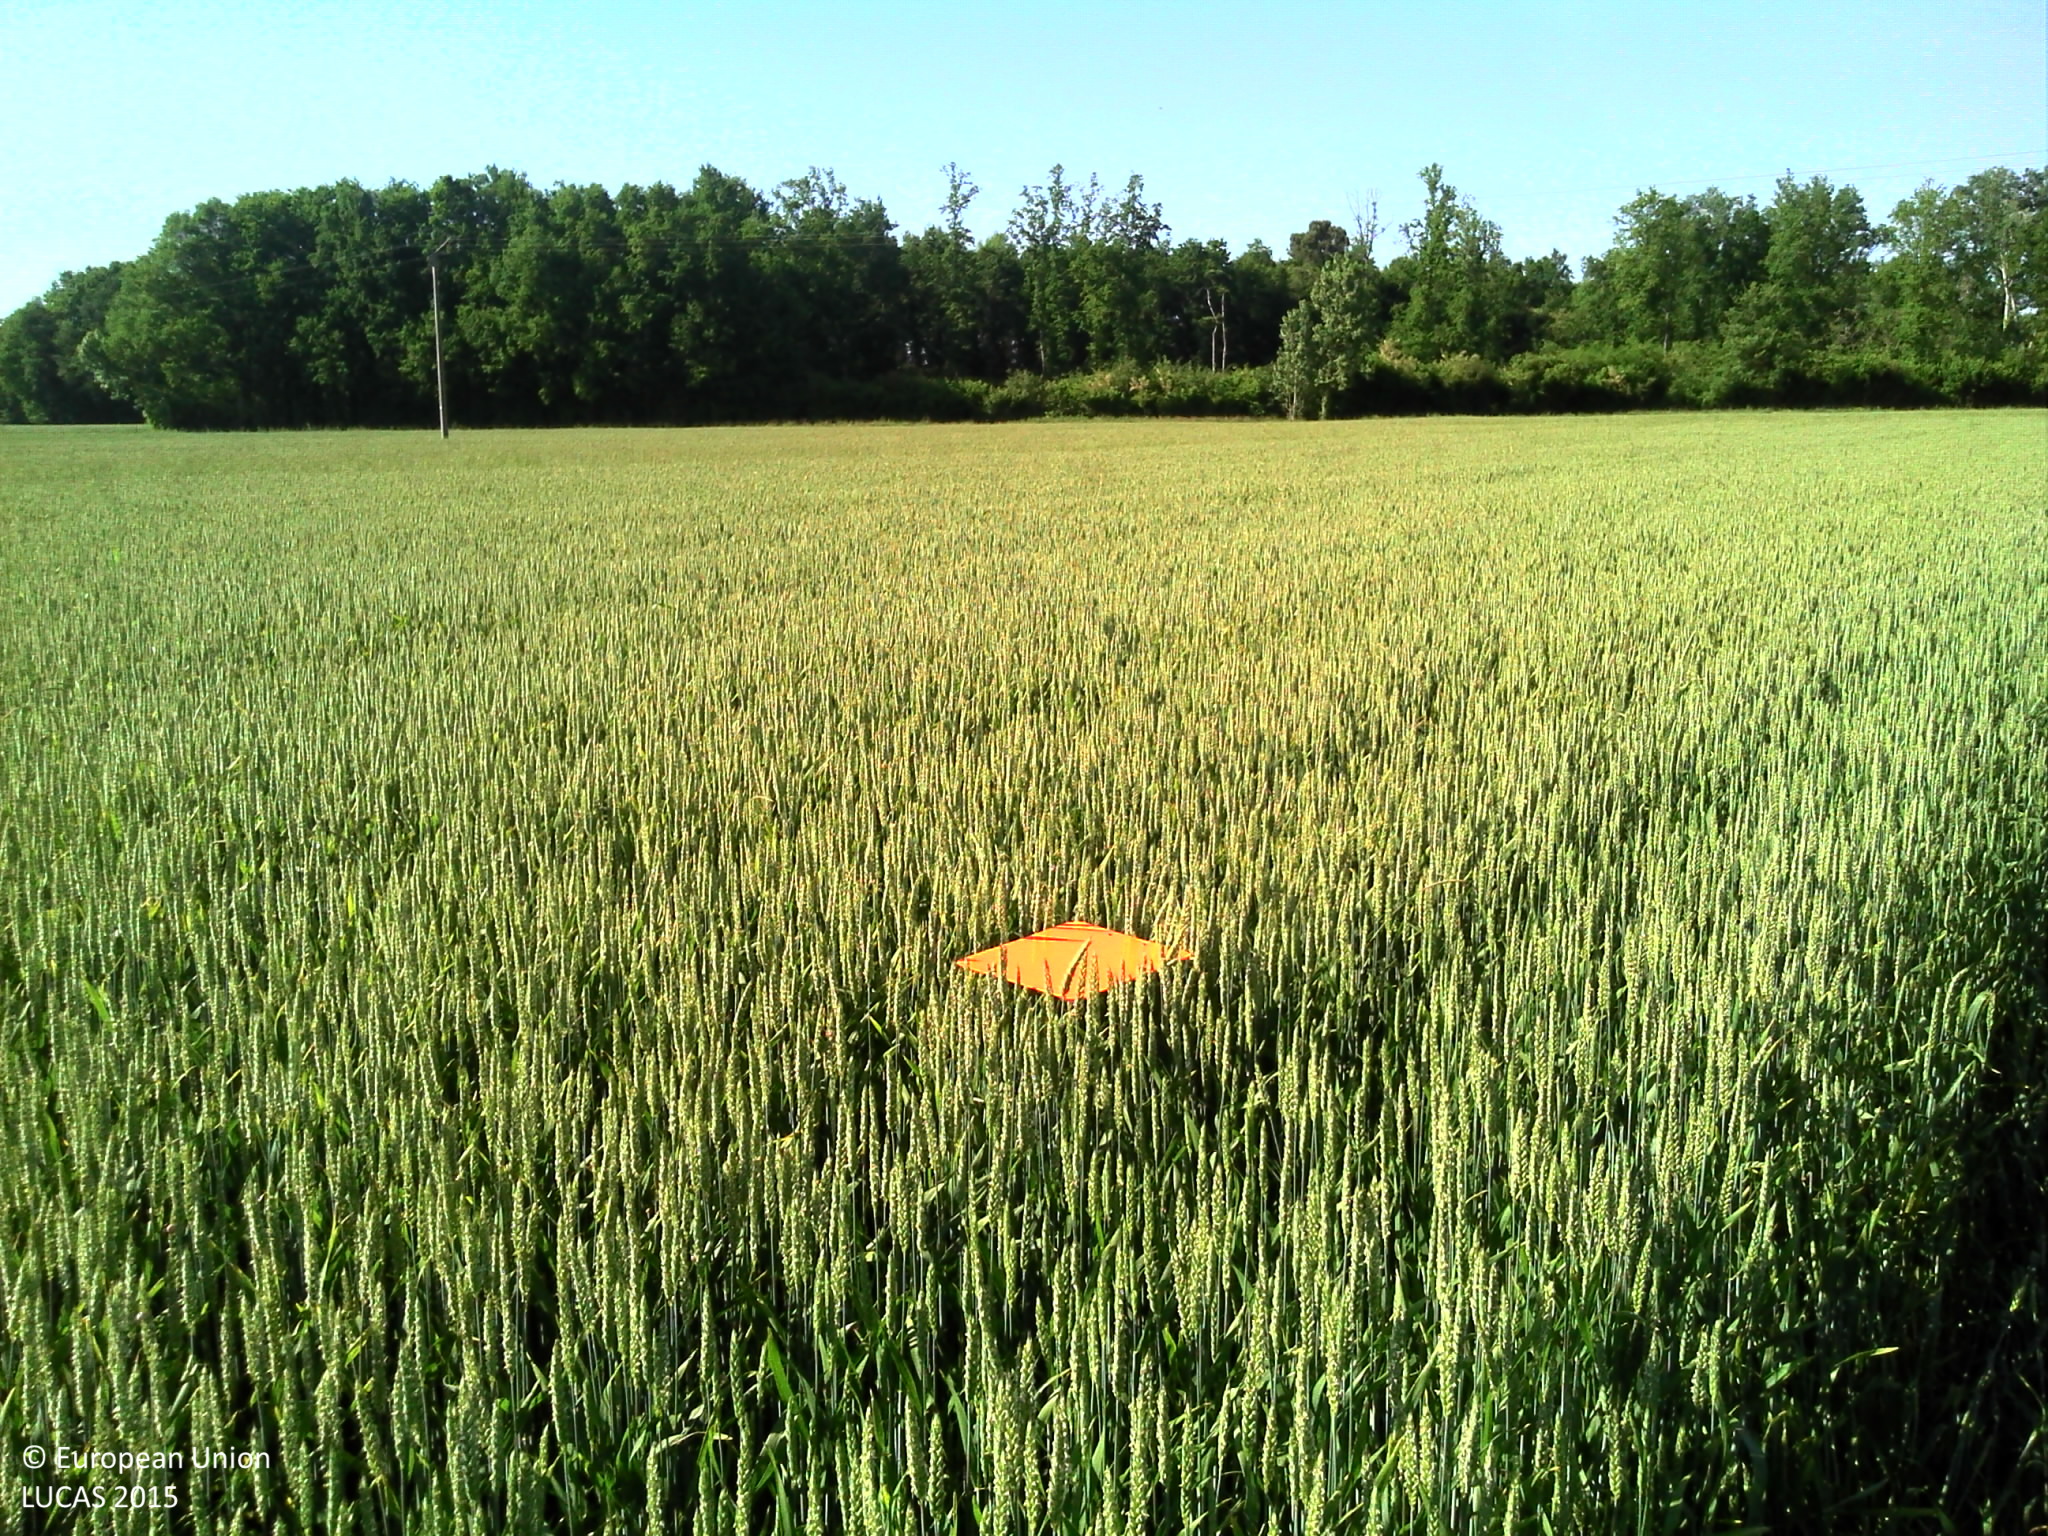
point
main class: Cropland
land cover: Common wheat
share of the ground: > 75 %
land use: Agriculture (excluding fallow land and kitchen gardens)
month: May
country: FR
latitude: 46.8239
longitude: 0.1867
